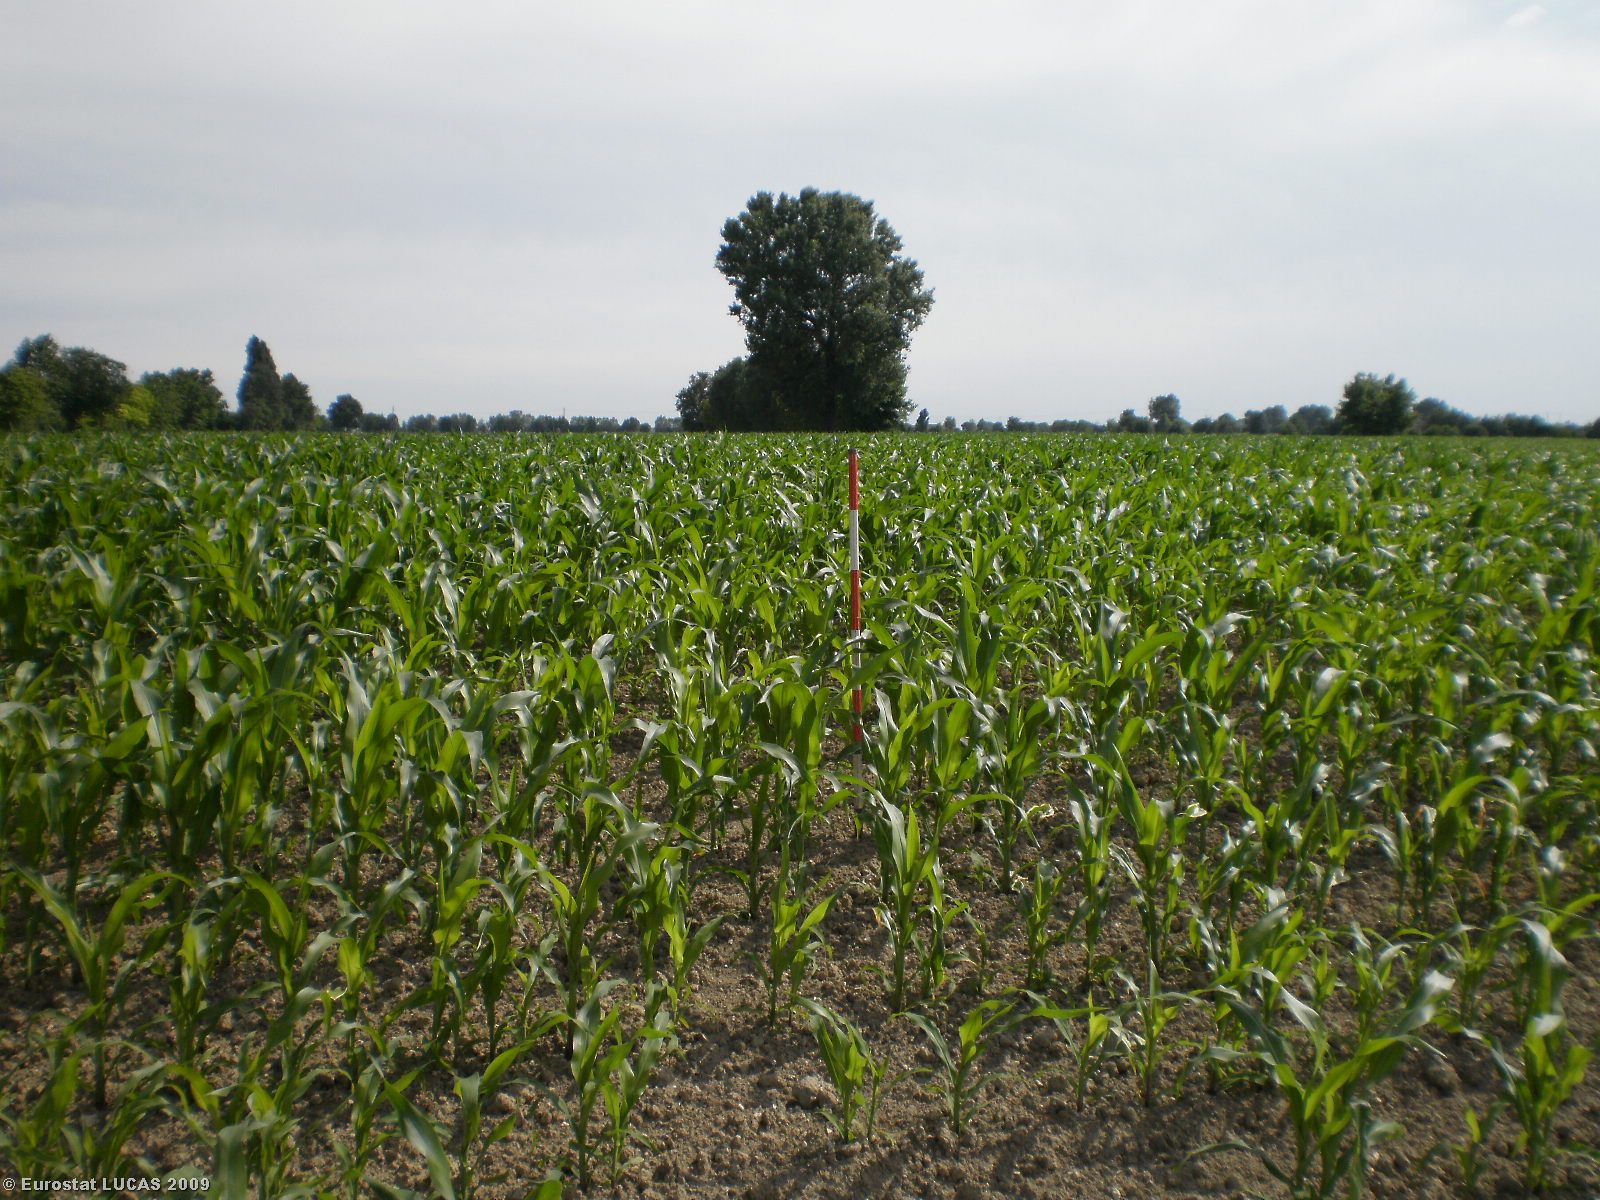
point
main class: Cropland
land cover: Maize
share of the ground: 50 - 75 %
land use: Agriculture (excluding fallow land and kitchen gardens)
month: May
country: IT
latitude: 45.2331
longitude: 10.4450
